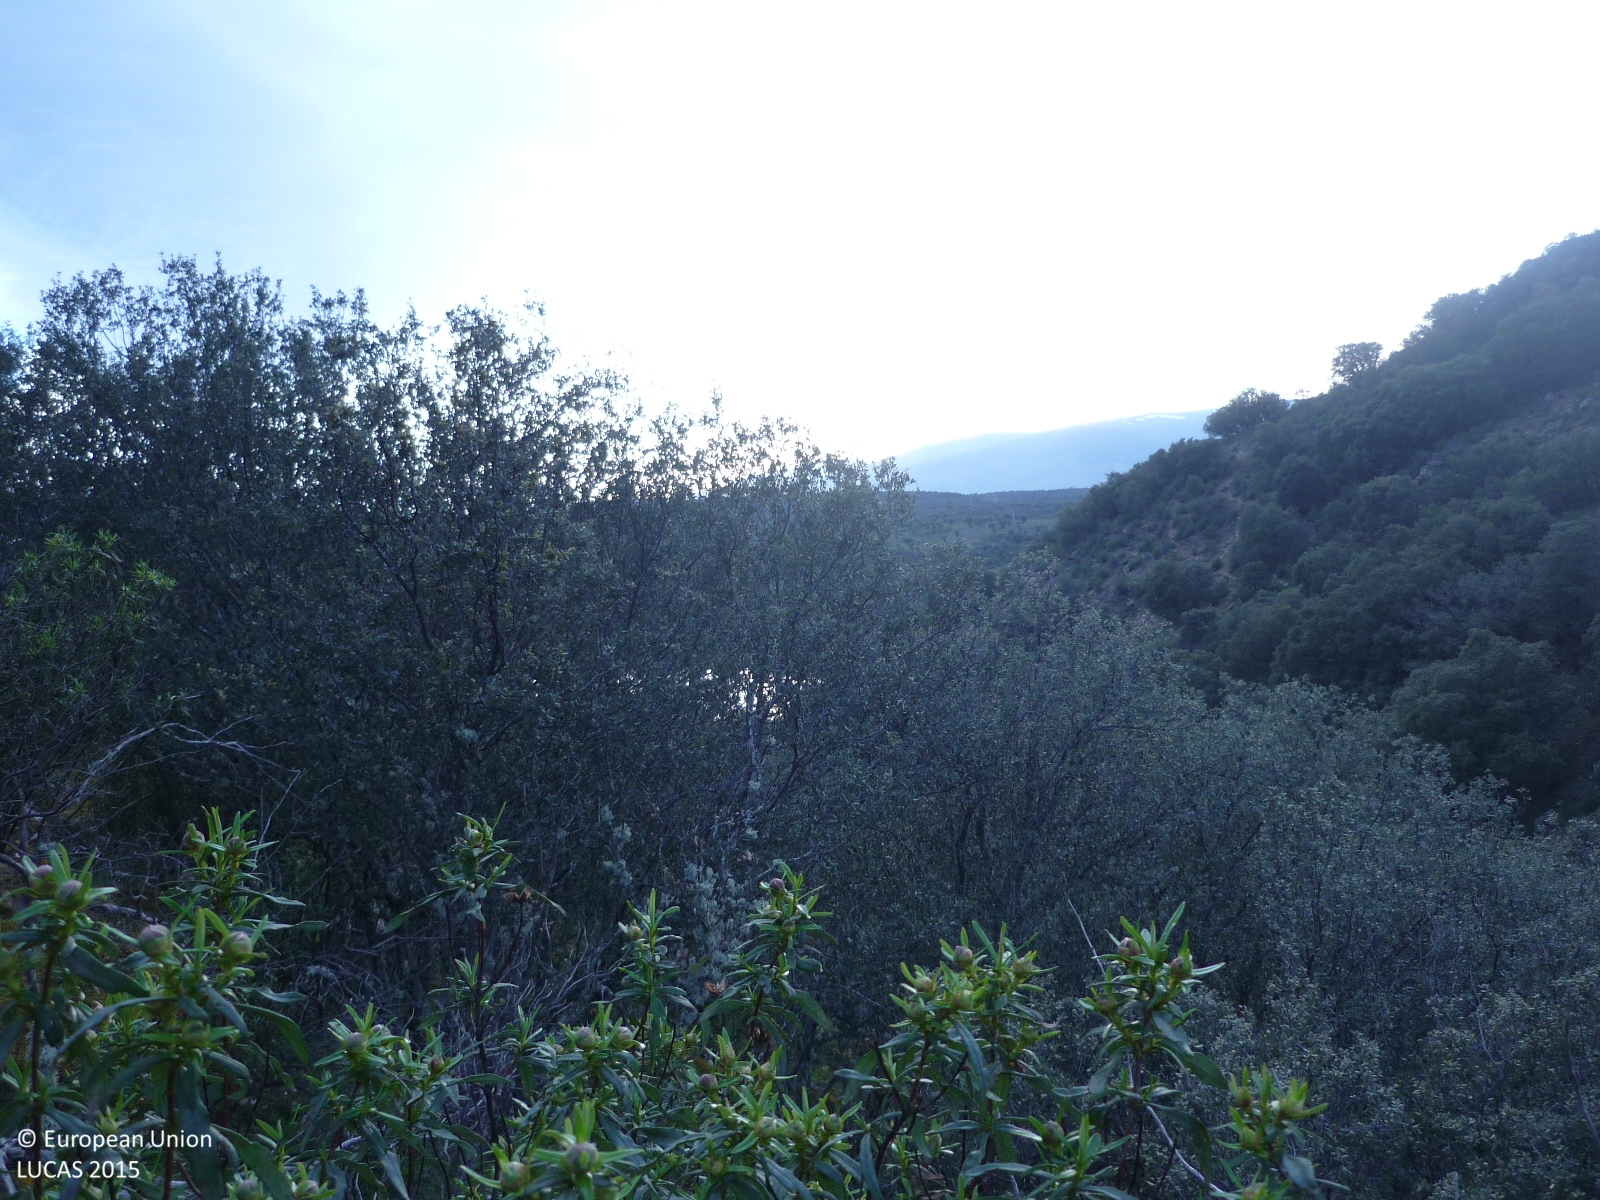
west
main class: Woodland
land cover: Broadleaved woodland
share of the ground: 50 - 75 %
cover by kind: broadleaved forest trees 50 %, herbaceous plants 30 %, shrubs 20 %
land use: Semi-natural and natural areas not in use
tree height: < 5 m
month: April
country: ES
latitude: 40.9877
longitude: -3.5575
